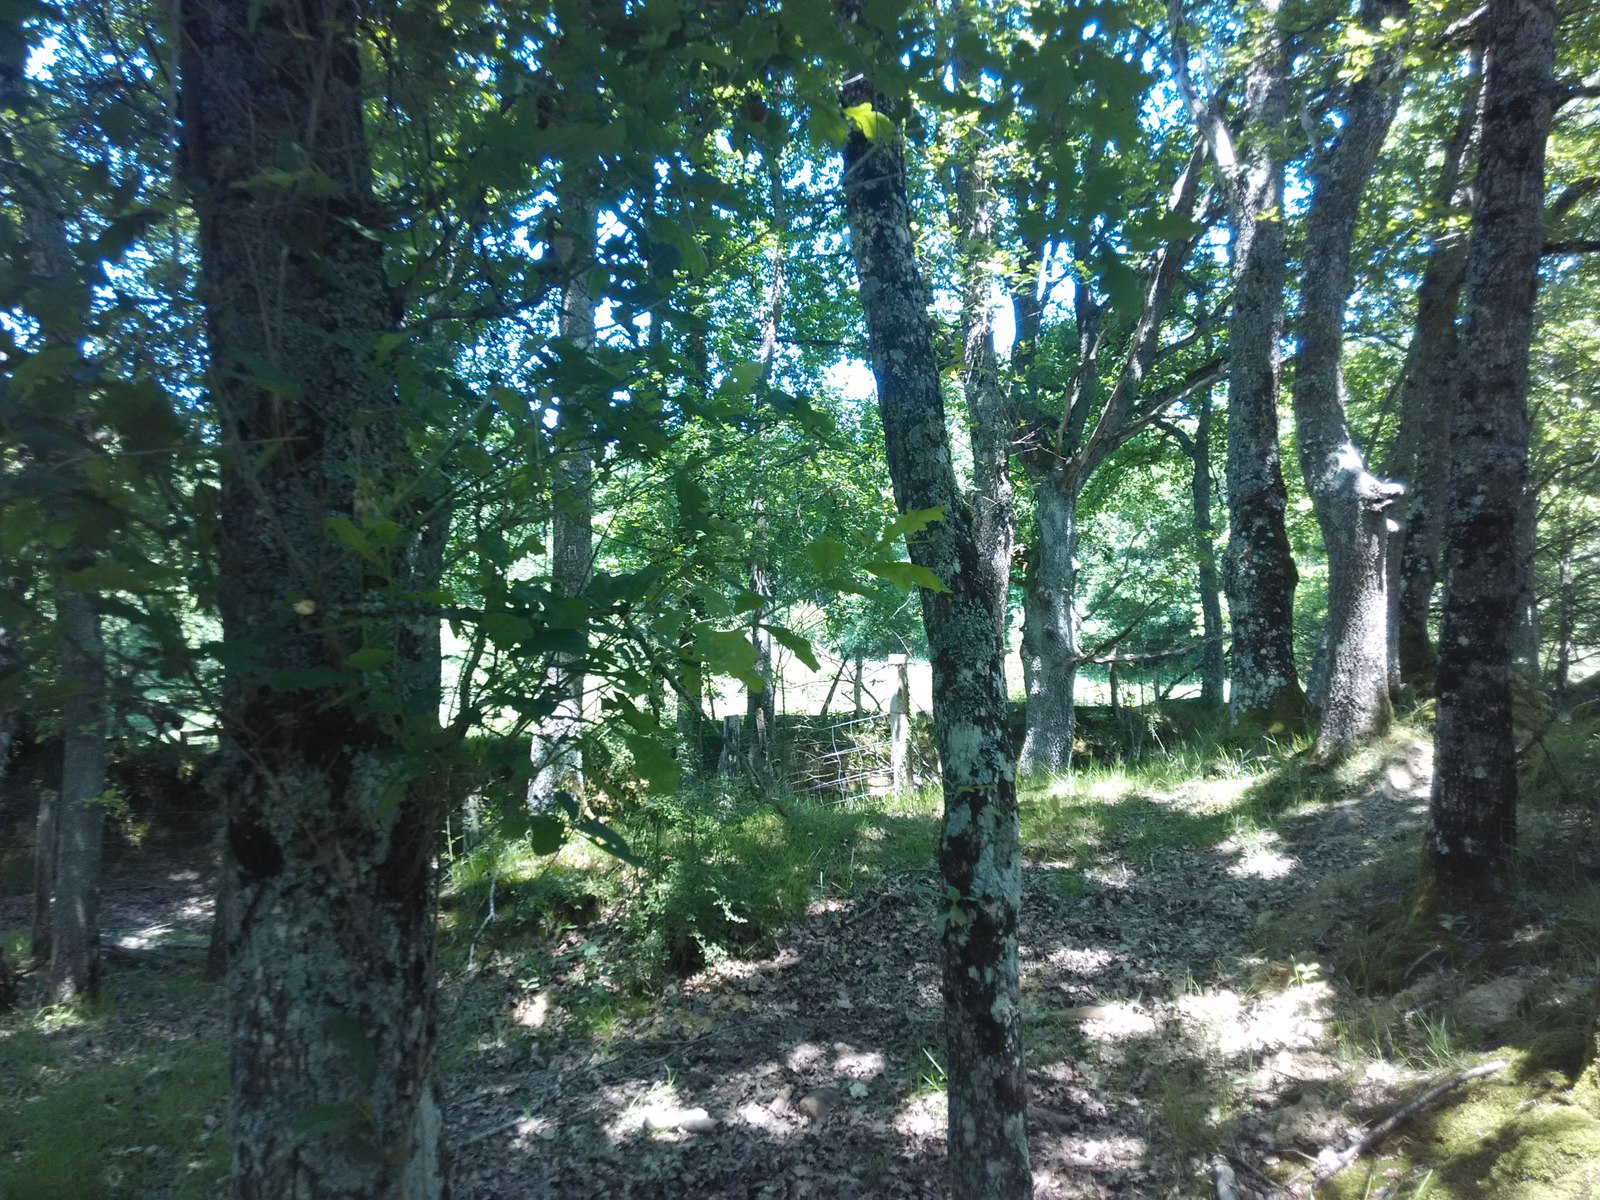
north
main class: Woodland
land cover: Broadleaved woodland
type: acidophilous oak and oak-birch forest
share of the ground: 50 - 75 %
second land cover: Grassland without tree/shrub cover
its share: 25 - 50 %
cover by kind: broadleaved forest trees 50 %, herbaceous plants 35 %, consolidated bare surface 10 %, shrubs 5 %
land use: Forestry
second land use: Agriculture (excluding fallow land and kitchen gardens)
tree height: > 5 m
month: June
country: ES
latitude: 42.9303
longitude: -2.5361
